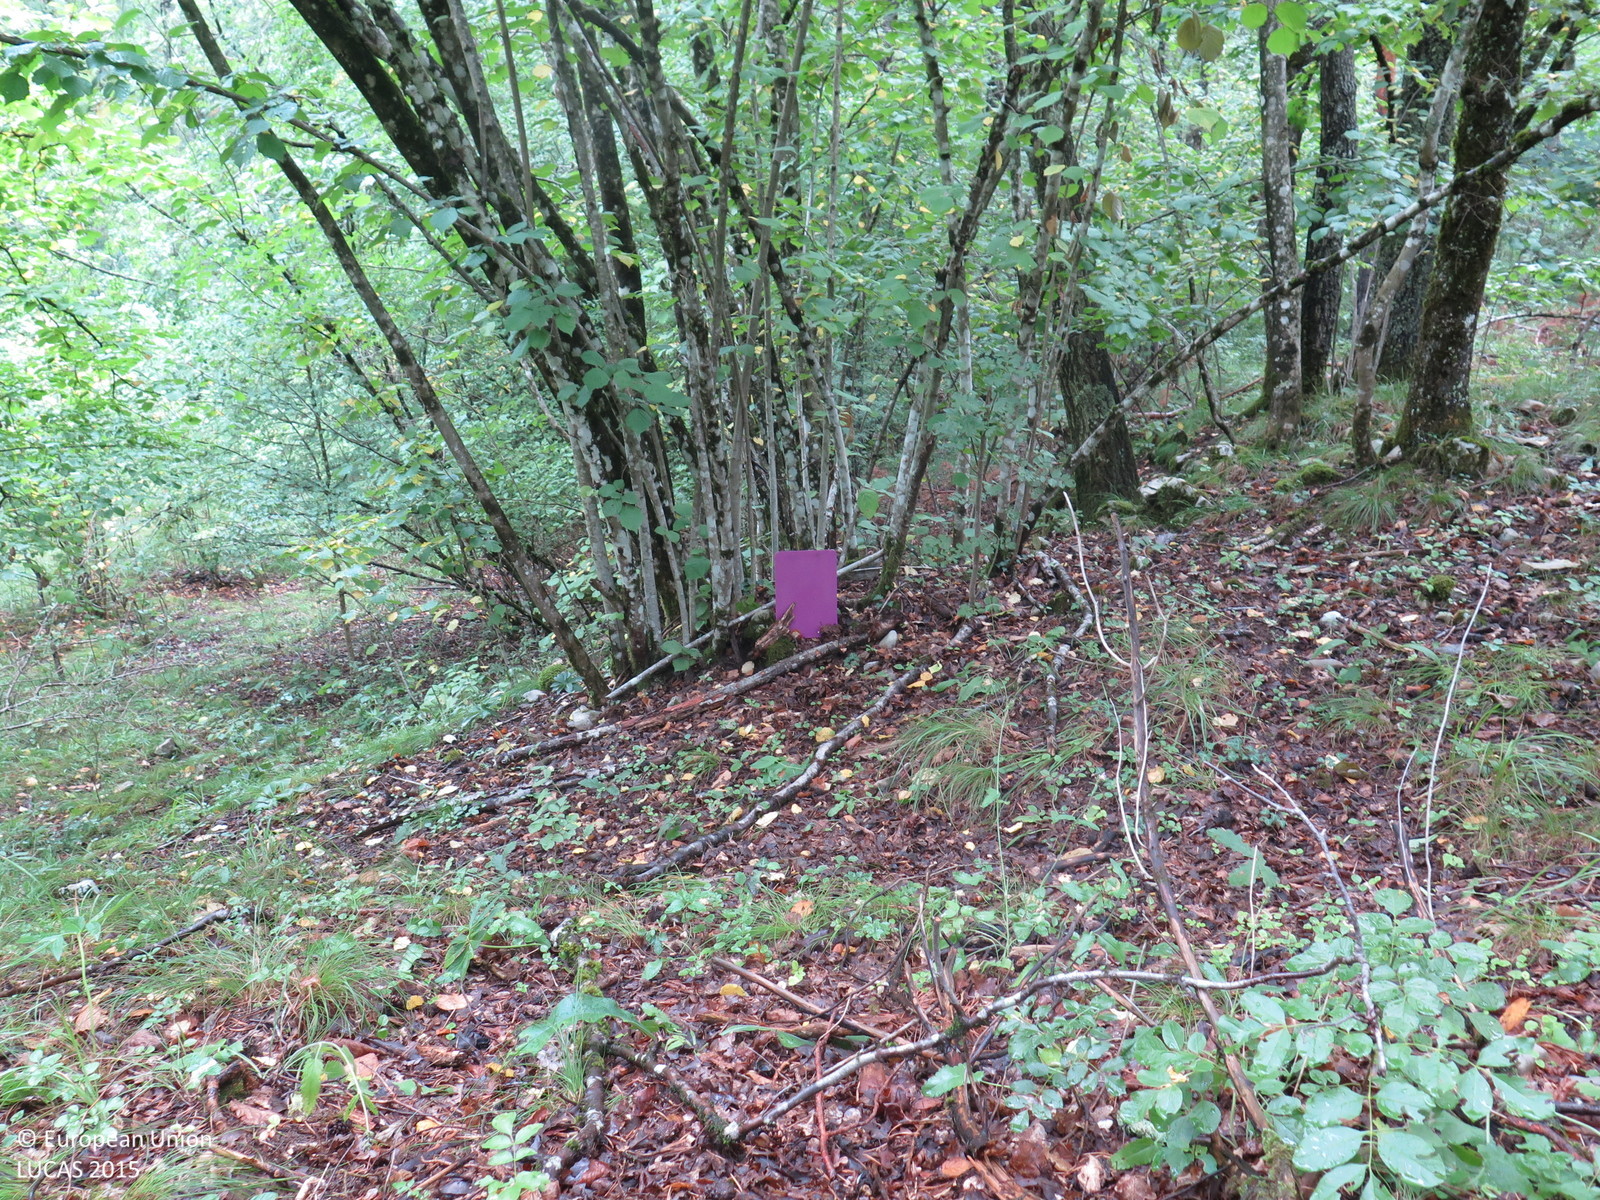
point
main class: Woodland
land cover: Broadleaved woodland
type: beech forest
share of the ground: > 75 %
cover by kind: broadleaved forest trees 95 %, herbaceous plants 5 %
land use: Semi-natural and natural areas not in use
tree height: > 5 m
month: August
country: HR
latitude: 45.4898
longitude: 14.2817
